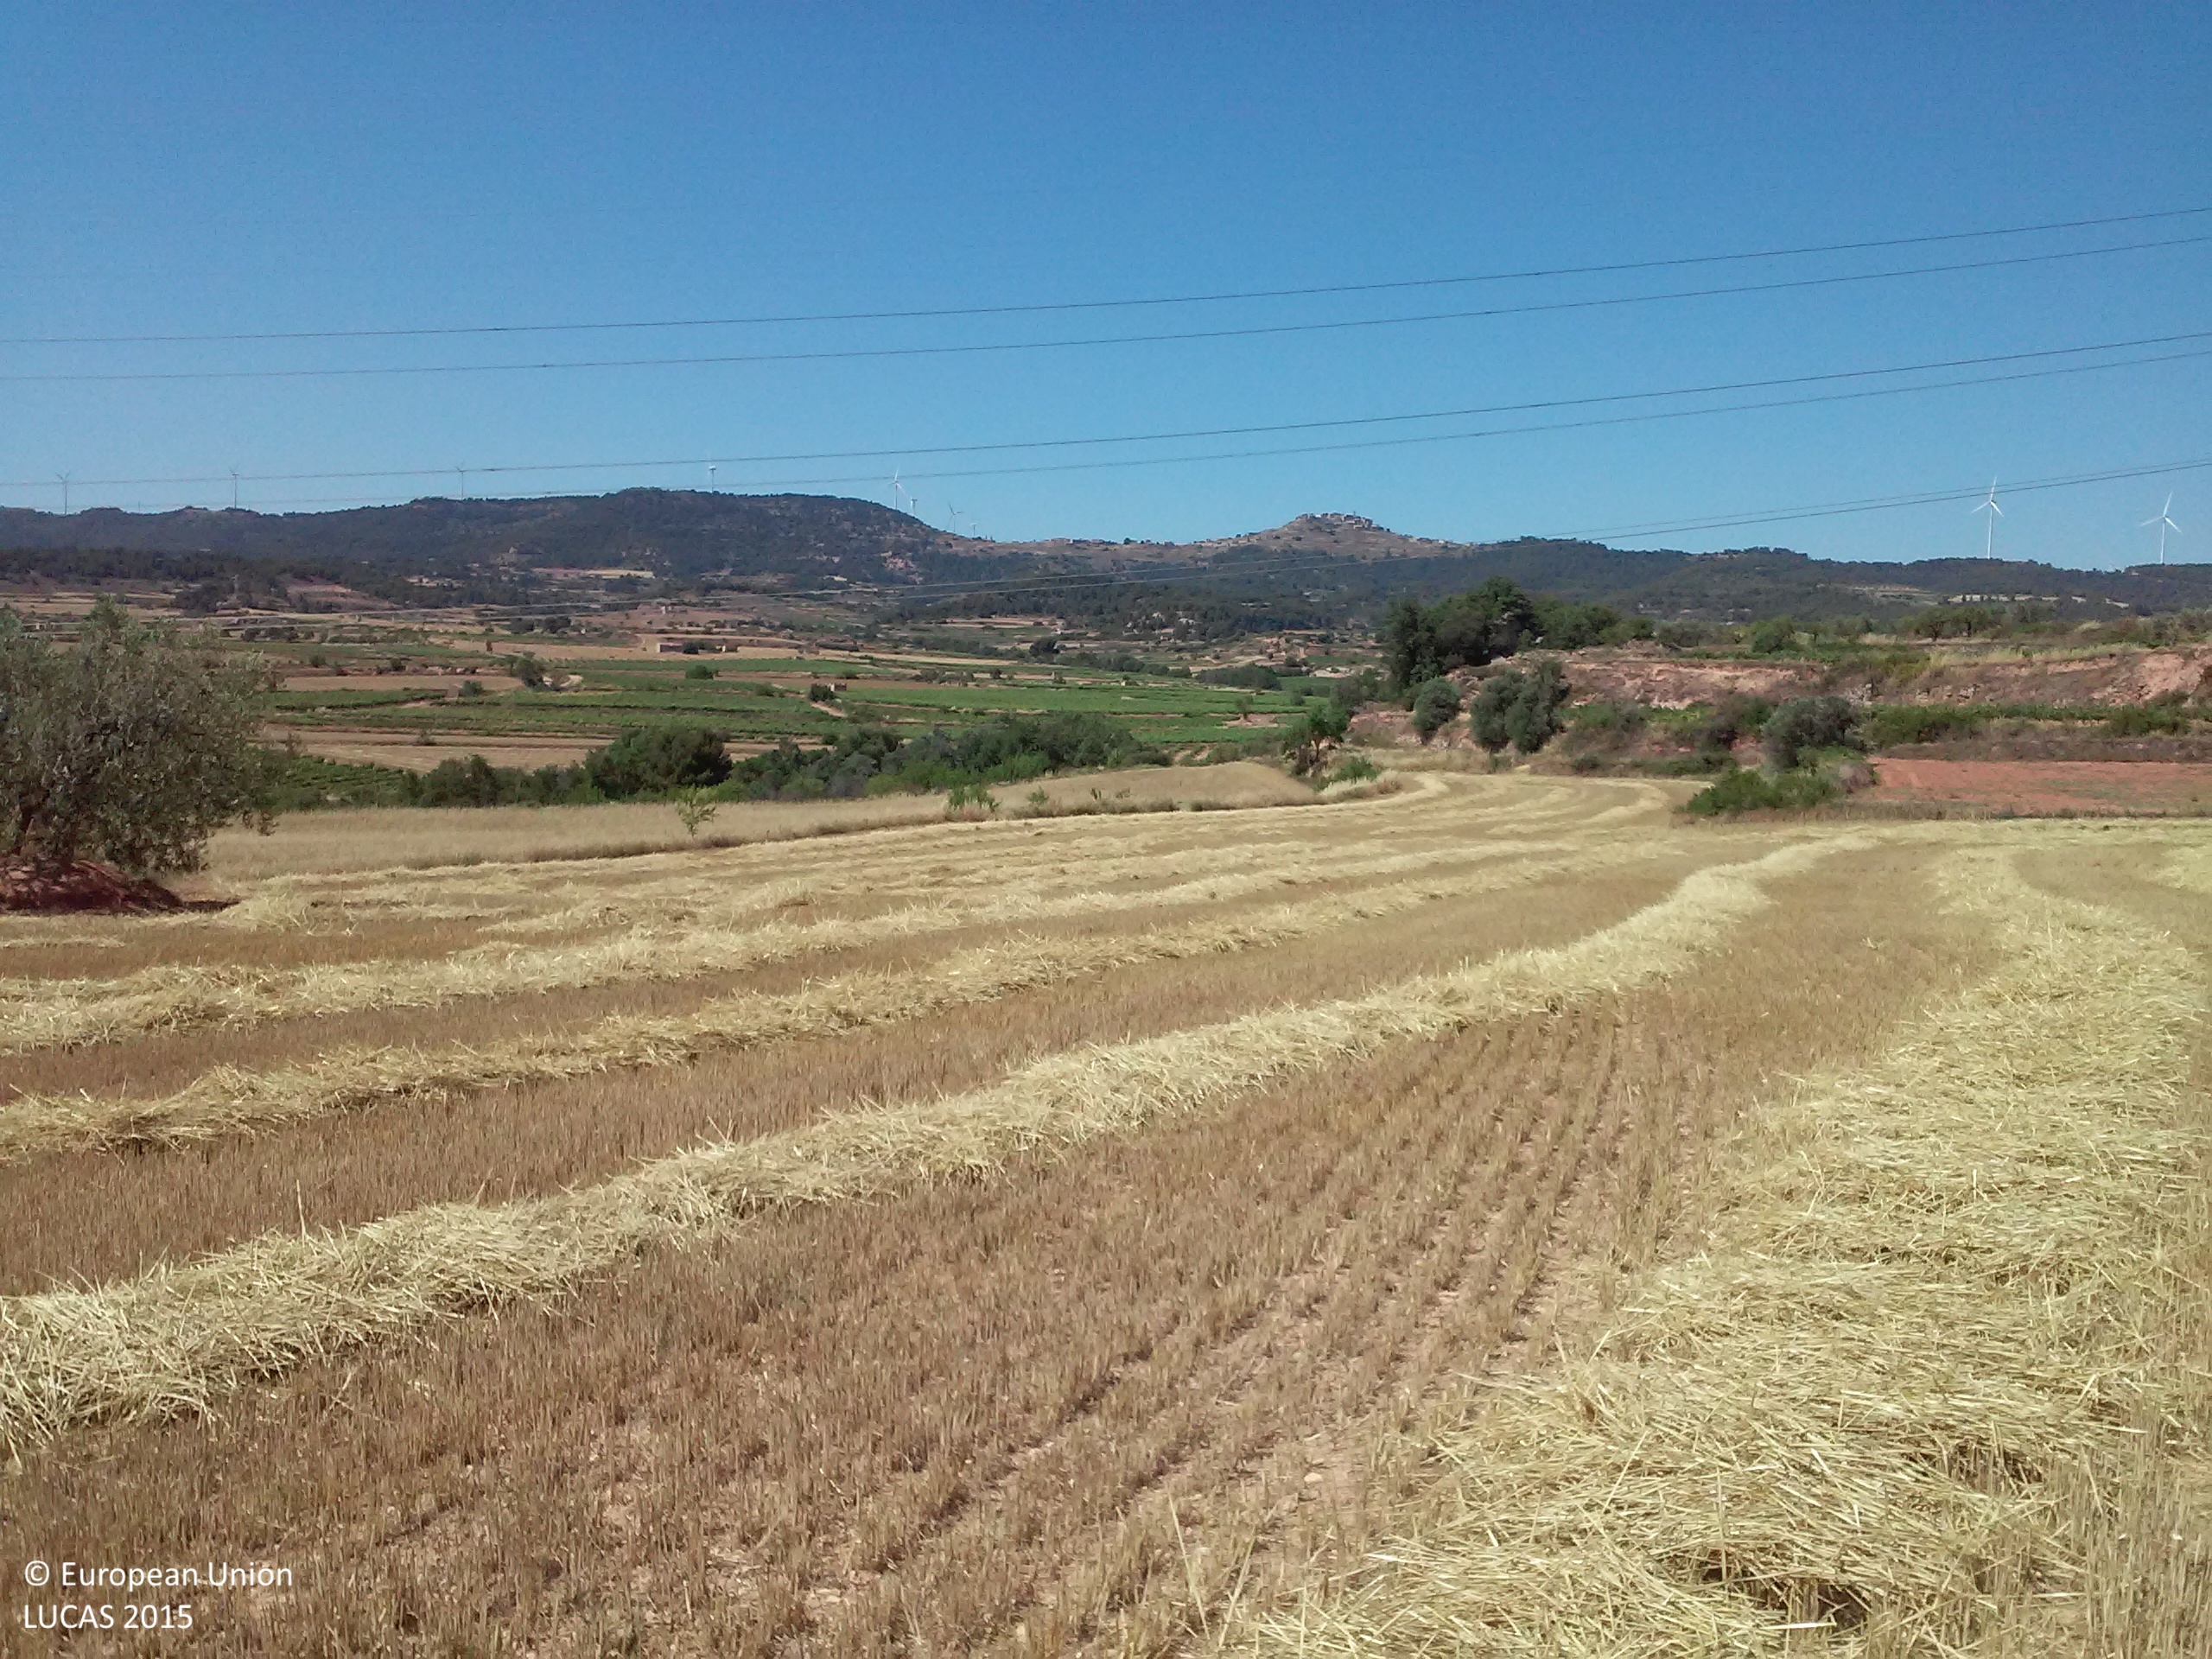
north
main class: Cropland
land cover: Barley
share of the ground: < 10 %
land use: Agriculture (excluding fallow land and kitchen gardens)
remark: Harvested field
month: June
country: ES
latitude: 41.4566
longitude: 1.2402
